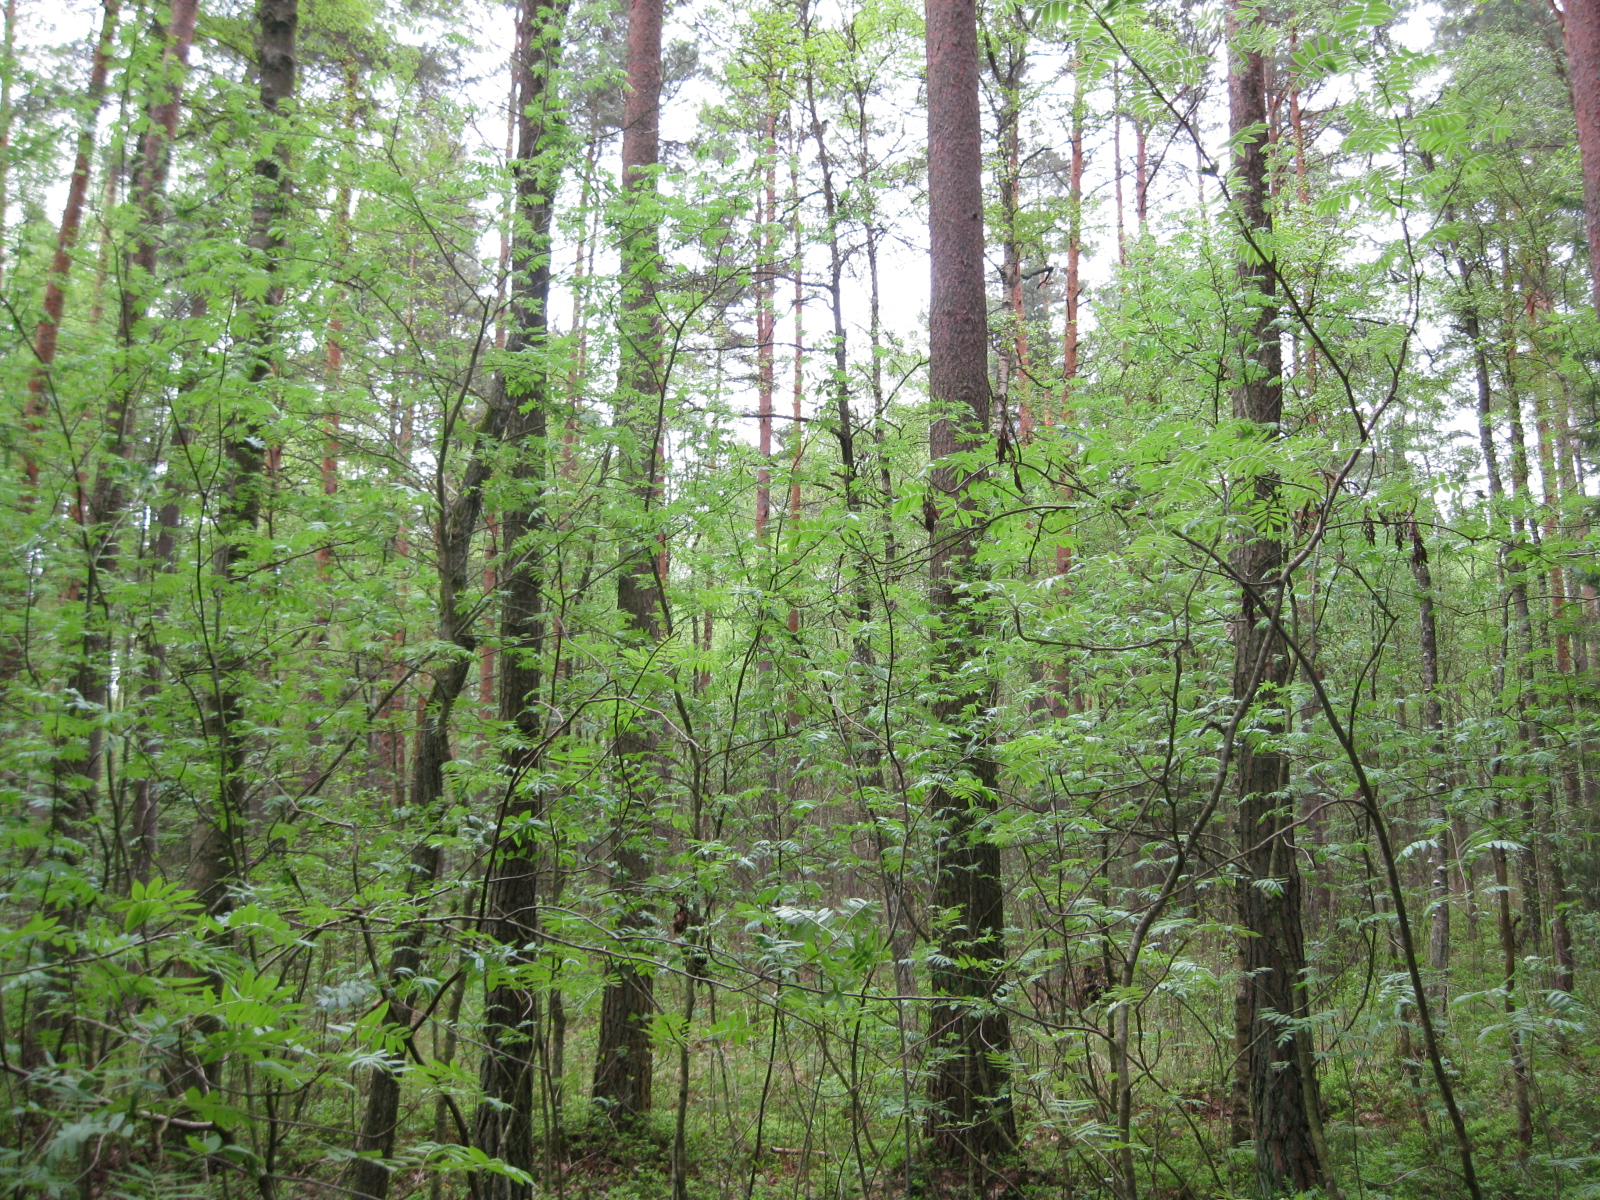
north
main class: Woodland
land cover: Other mixed woodland
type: hemiboreal forest and nemoral coniferous forest and mixed broadleaved-coniferous forest
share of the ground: > 75 %
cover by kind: coniferous forest trees 45 %, broadleaved forest trees 40 %, shrubs 5 %, herbaceous plants 5 %, lichens and mosses 5 %
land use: Forestry
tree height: > 5 m
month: May
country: LT
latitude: 55.9588
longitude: 24.3671
